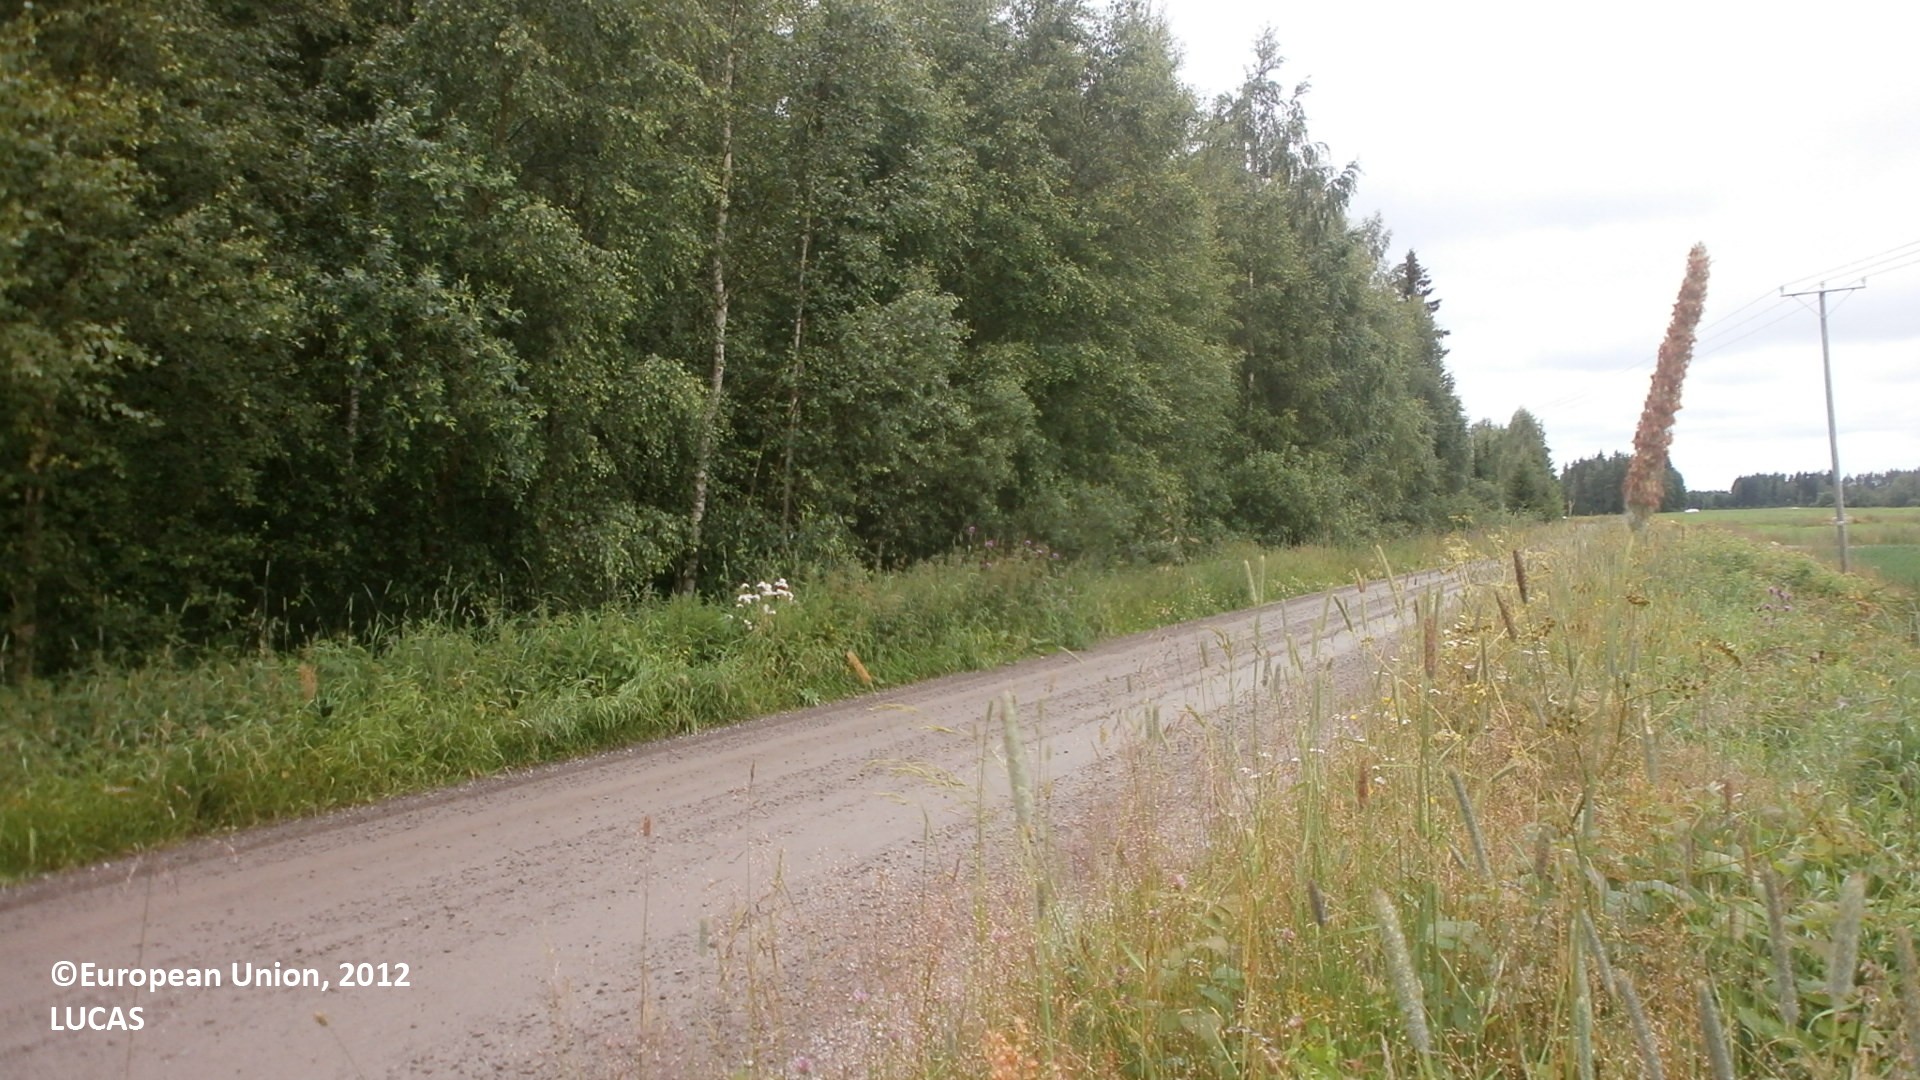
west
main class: Grassland
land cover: Grassland without tree/shrub cover
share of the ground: > 75 %
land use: Road transport
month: July
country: FI
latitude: 63.9781
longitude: 23.7701
